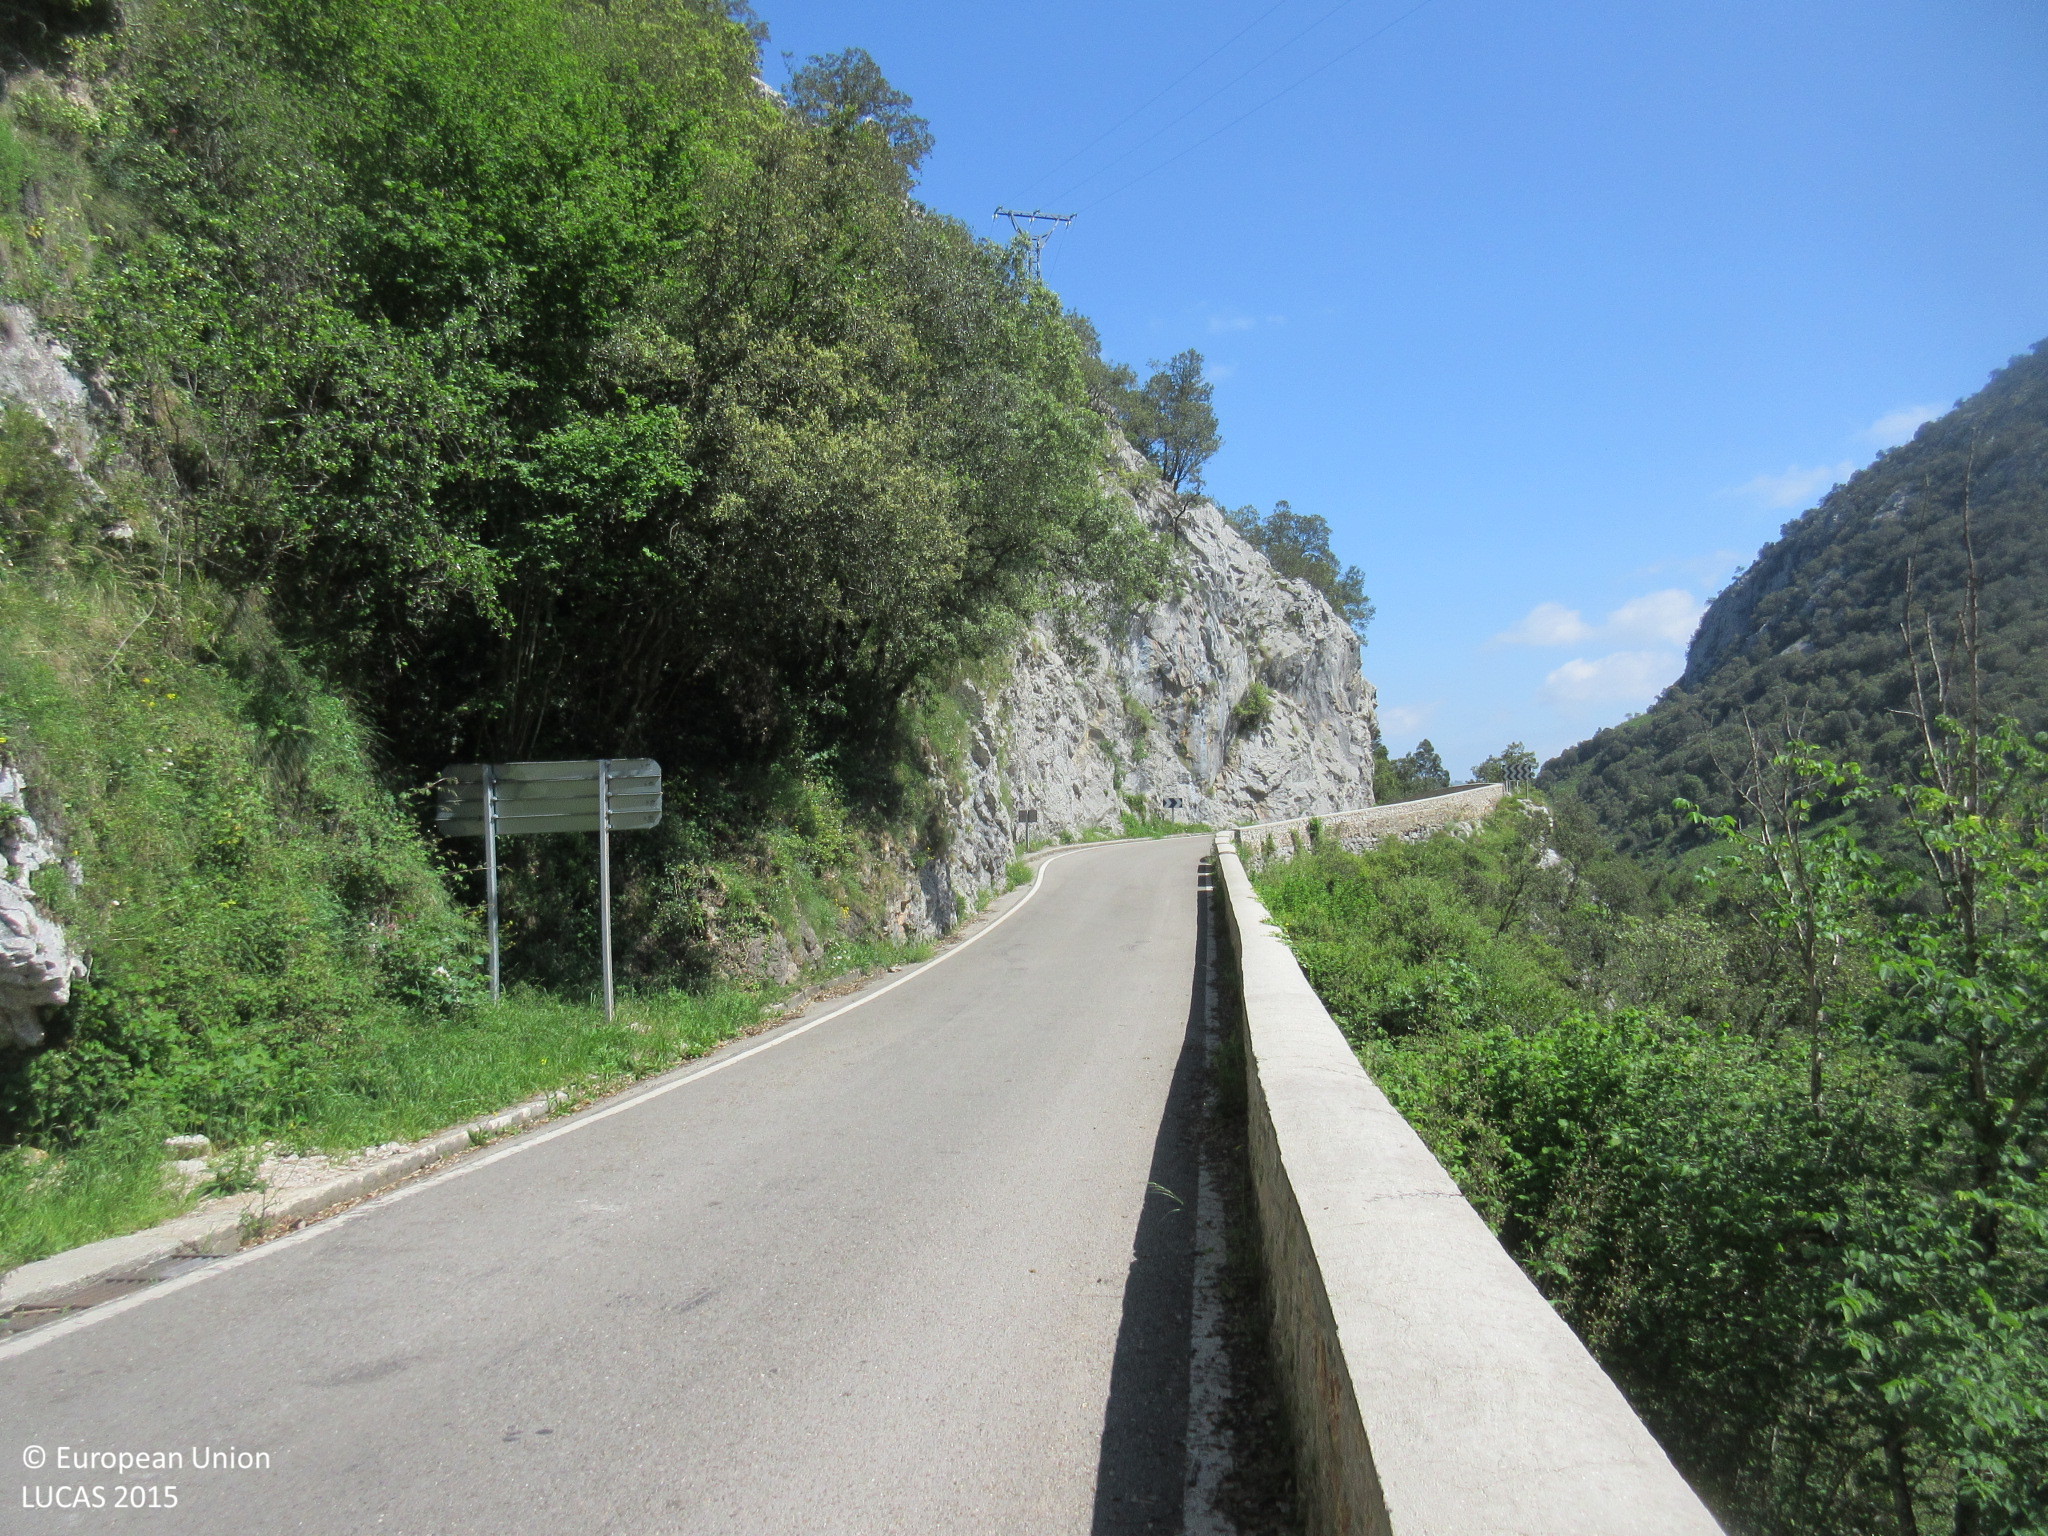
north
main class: Woodland
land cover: Broadleaved woodland
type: broadleaved evergreen forest
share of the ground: > 75 %
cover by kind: broadleaved forest trees 90 %, shrubs 5 %, herbaceous plants 5 %
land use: Semi-natural and natural areas not in use
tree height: > 5 m
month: May
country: ES
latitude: 43.2726
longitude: -4.4874
